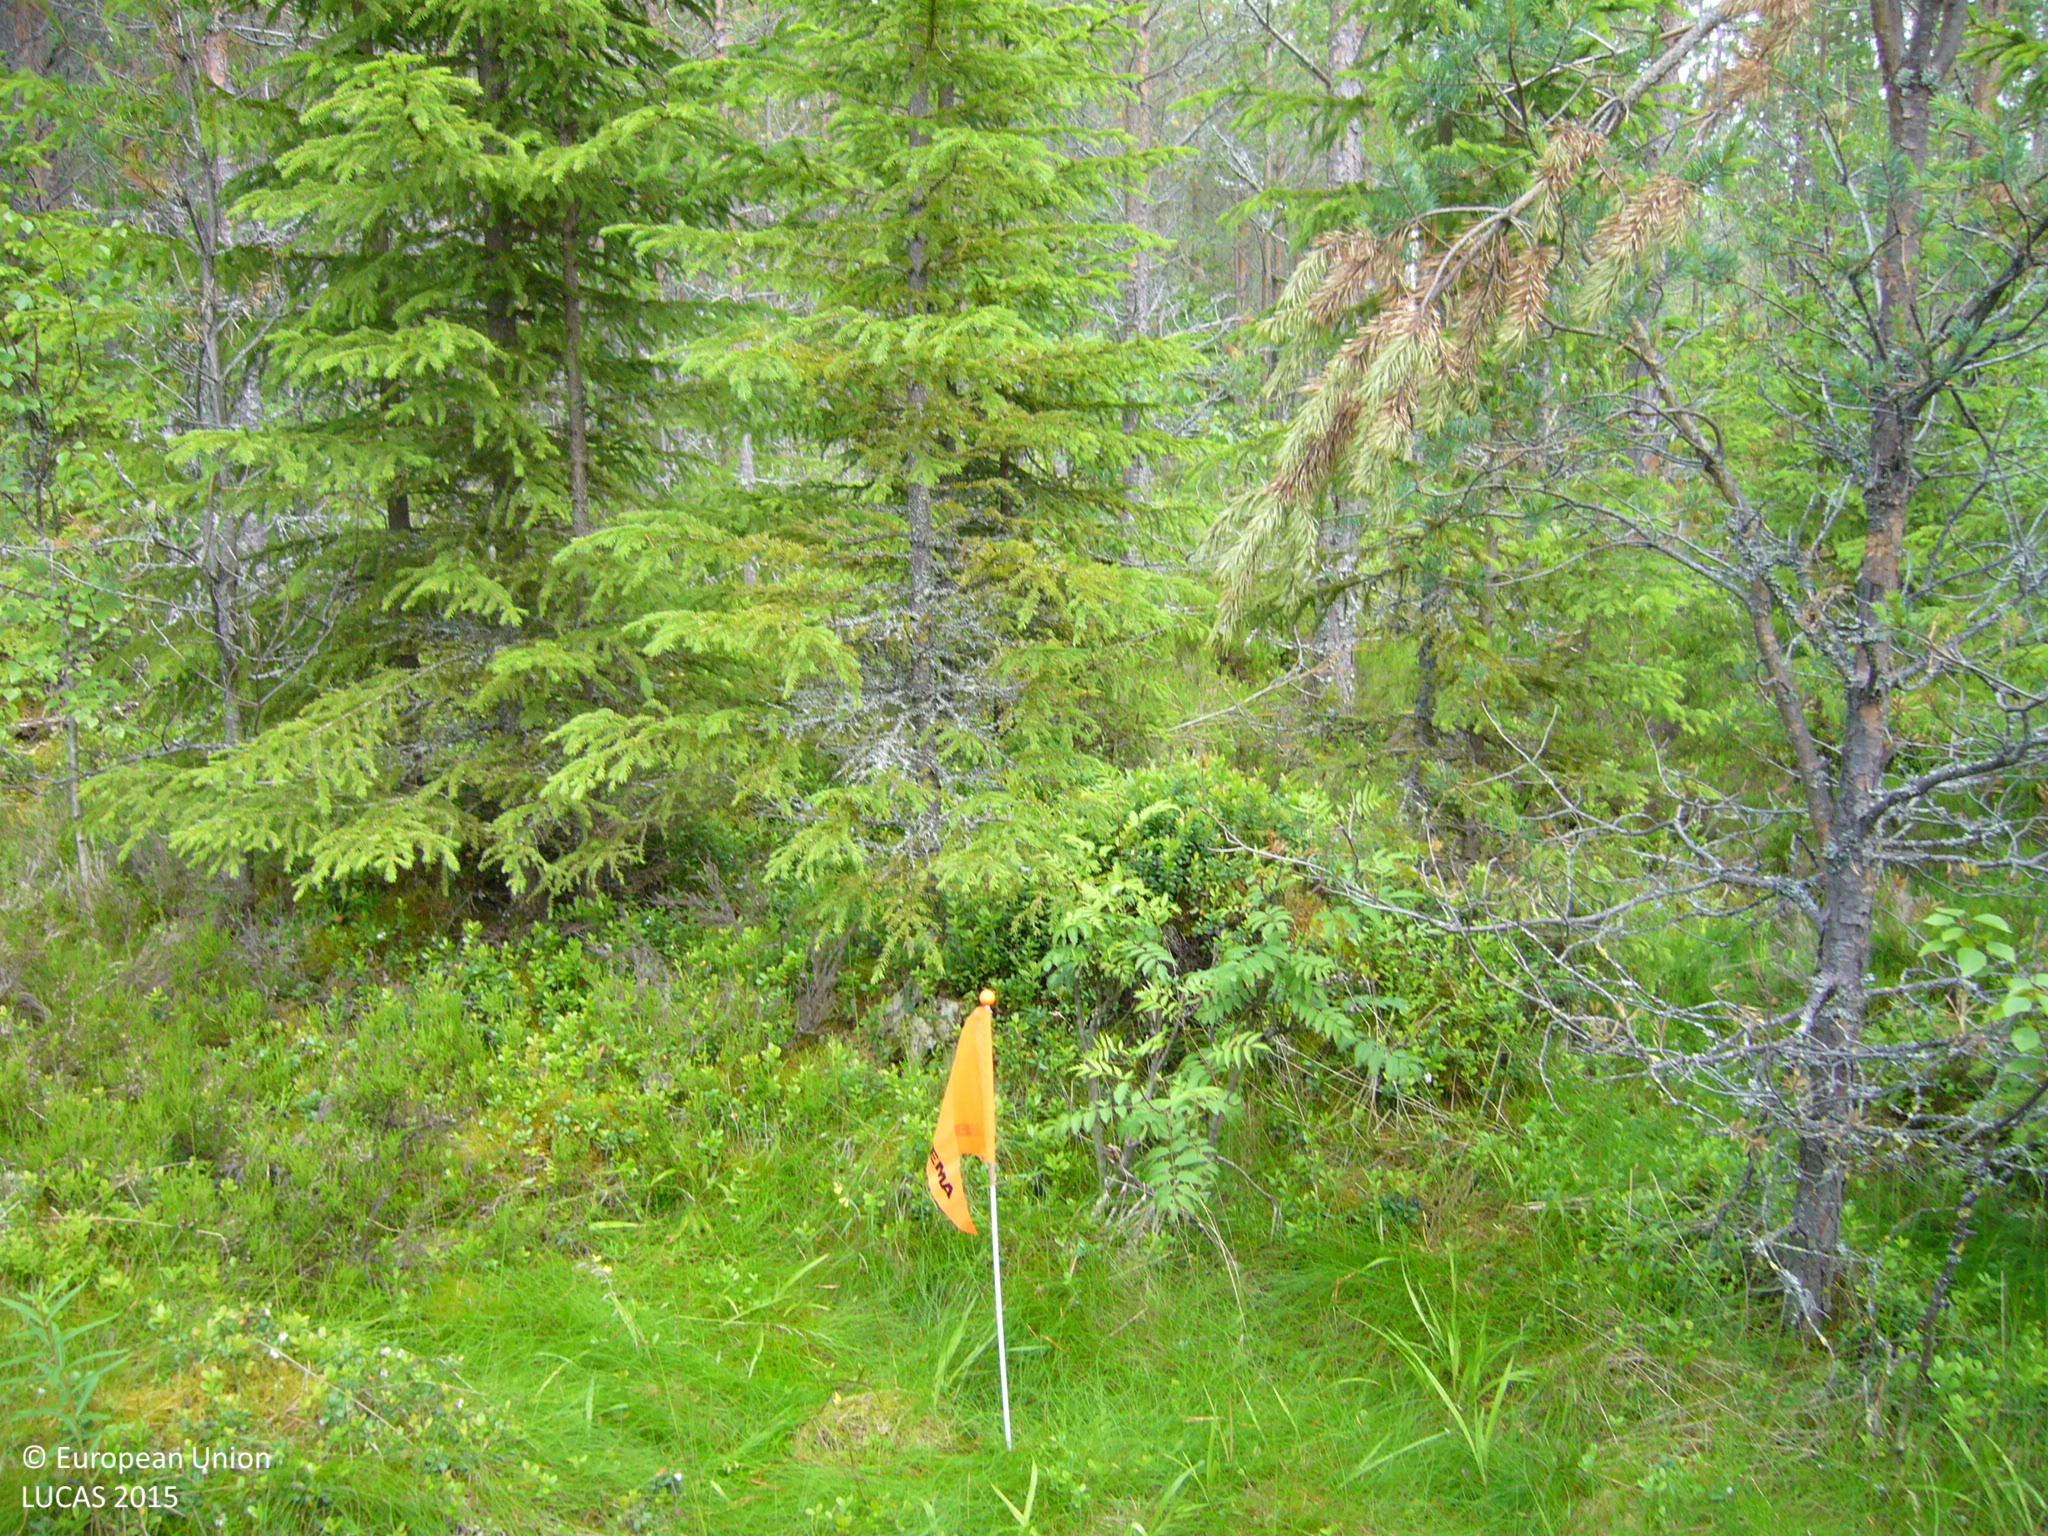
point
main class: Woodland
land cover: Pine dominated coniferous woodland
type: boreal forest
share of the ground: 50 - 75 %
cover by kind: coniferous forest trees 60 %, shrubs 40 %
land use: Forestry
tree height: > 5 m
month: July
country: FI
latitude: 63.5616
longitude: 25.6248
